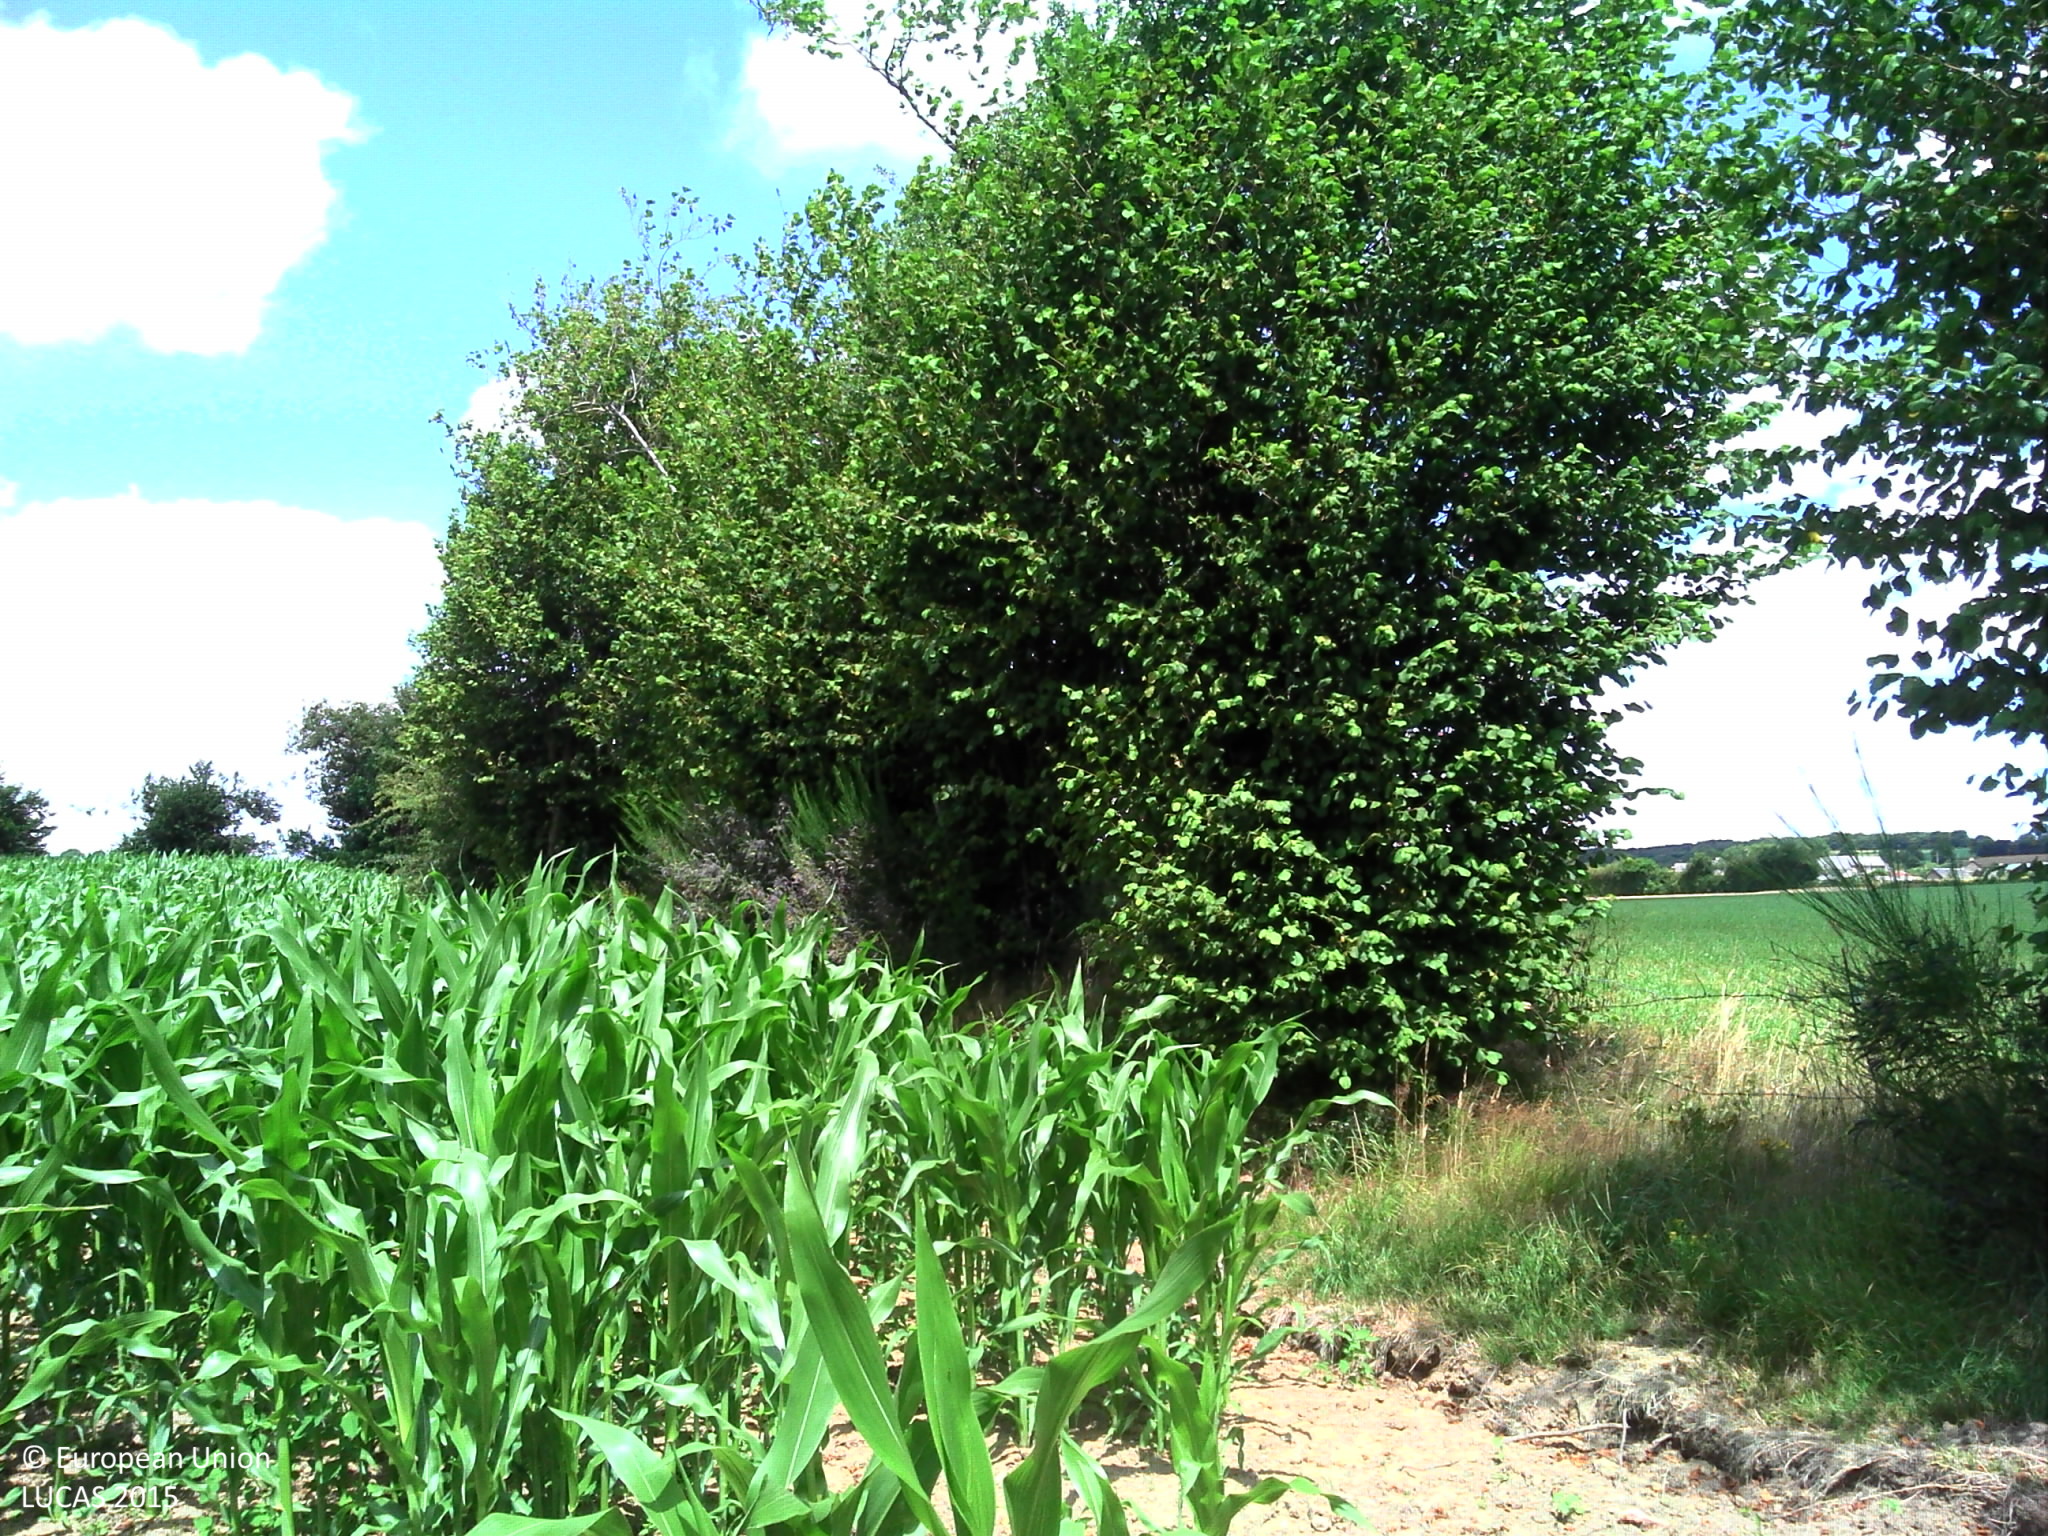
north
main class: Cropland
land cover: Maize
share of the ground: > 75 %
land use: Agriculture (excluding fallow land and kitchen gardens)
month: July
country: FR
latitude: 48.5467
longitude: -0.2049
